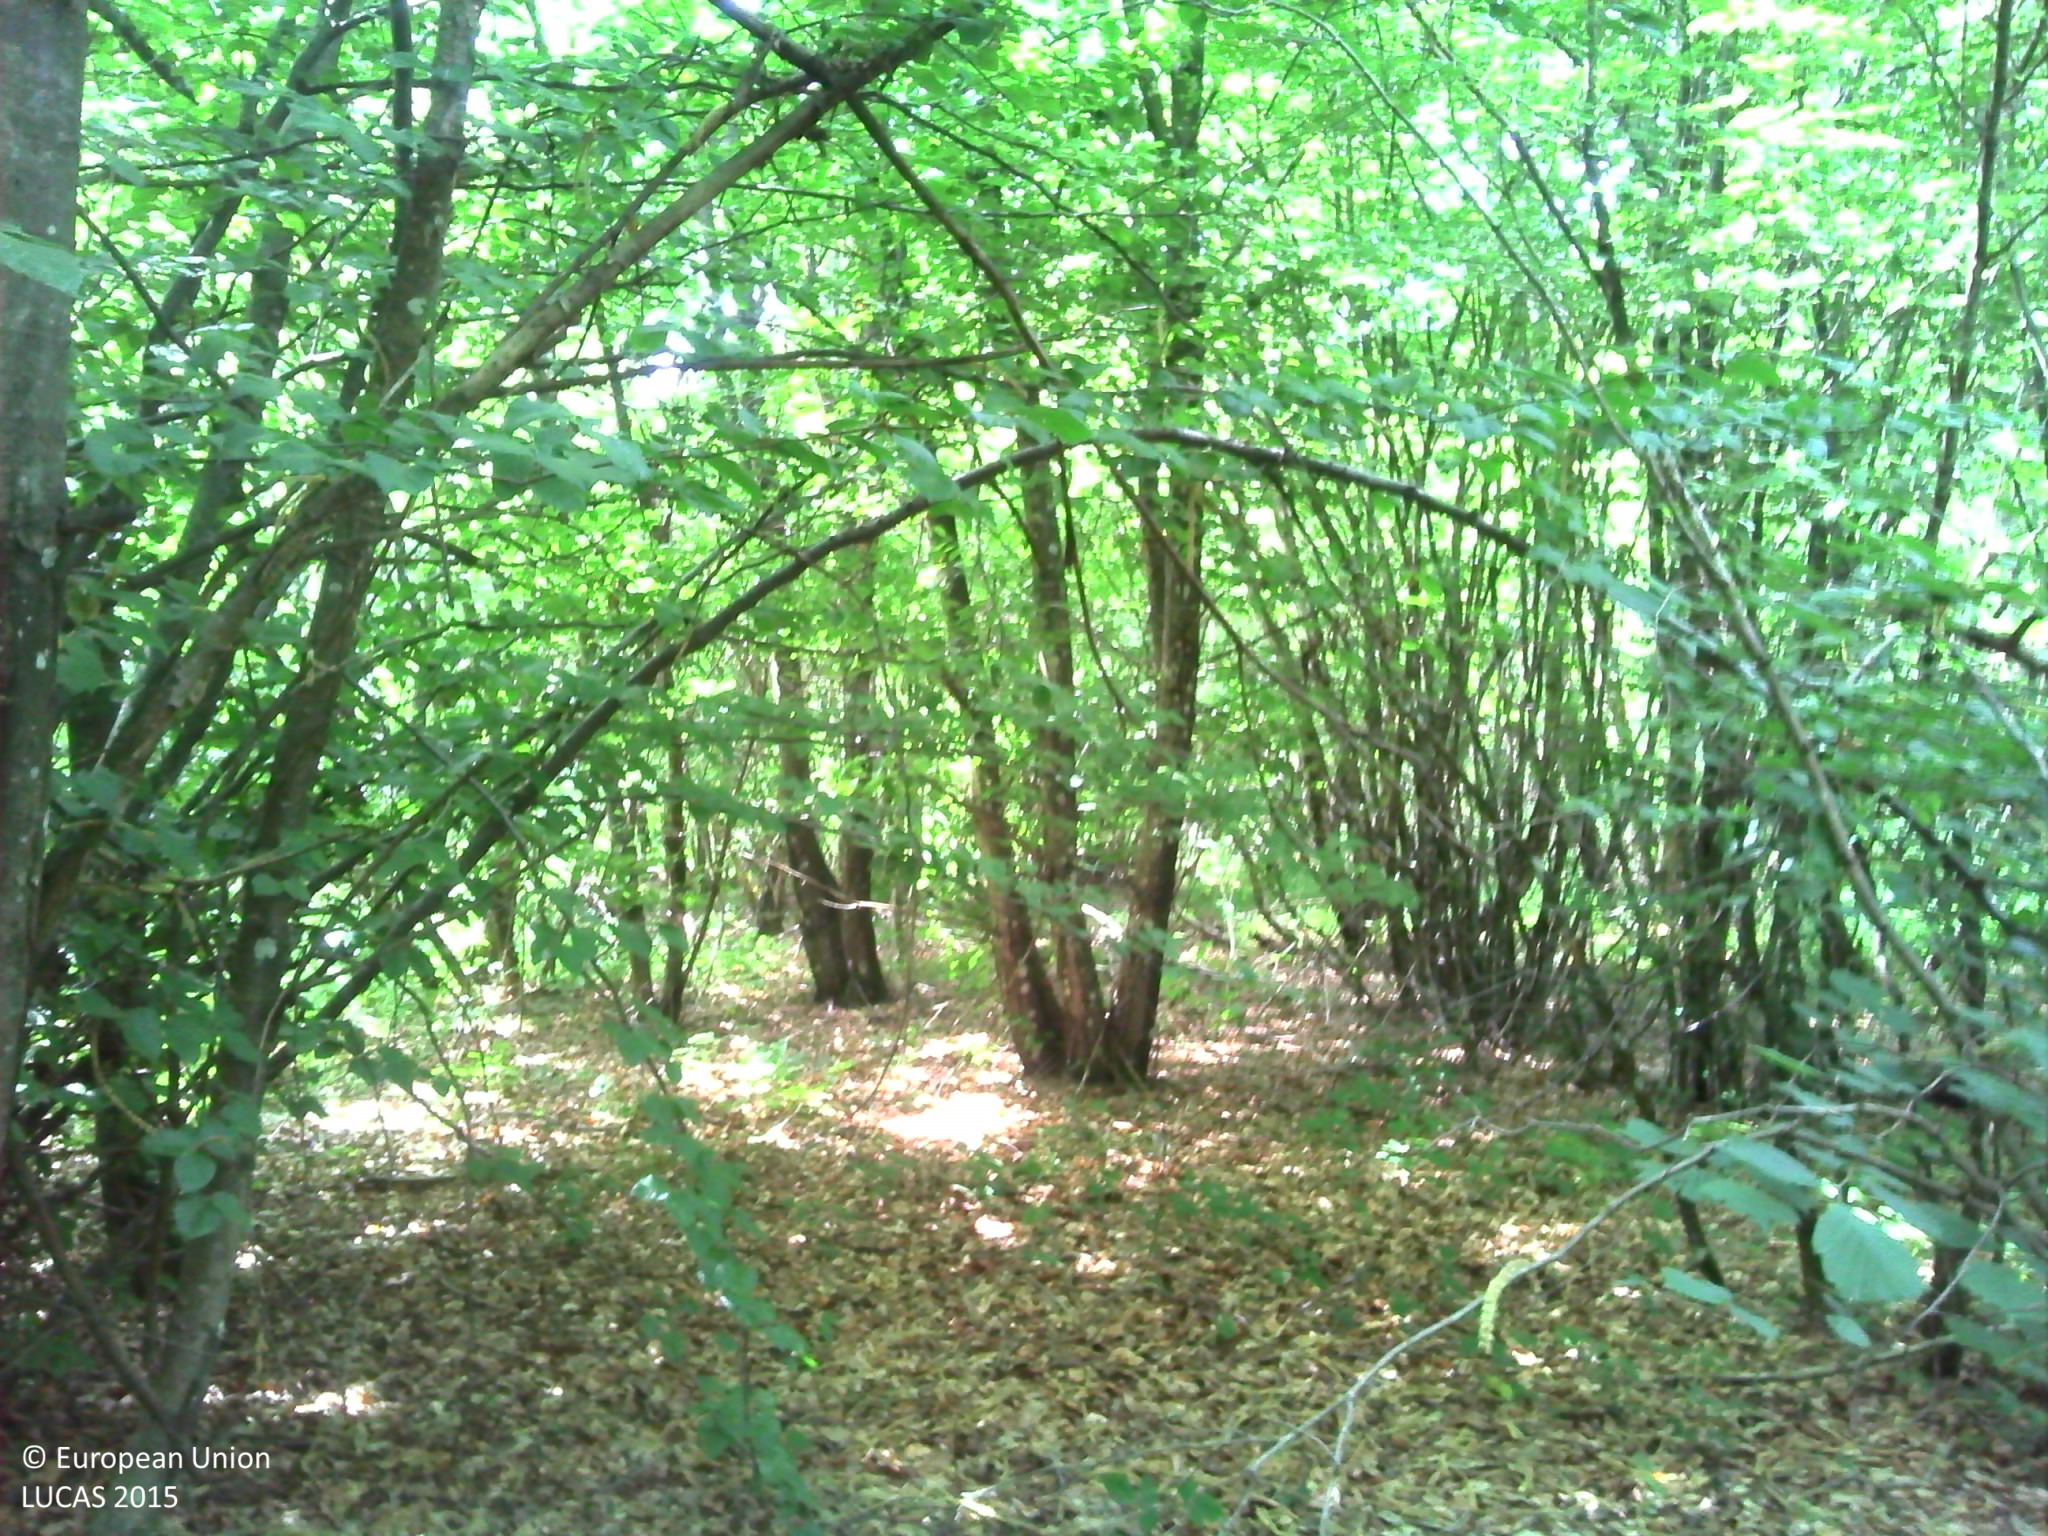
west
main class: Woodland
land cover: Broadleaved woodland
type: acidophilous oak and oak-birch forest
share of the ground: > 75 %
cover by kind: broadleaved forest trees 80 %, herbaceous plants 10 %, consolidated bare surface 10 %
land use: Forestry
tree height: > 5 m
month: July
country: FR
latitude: 45.2903
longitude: 5.2746
